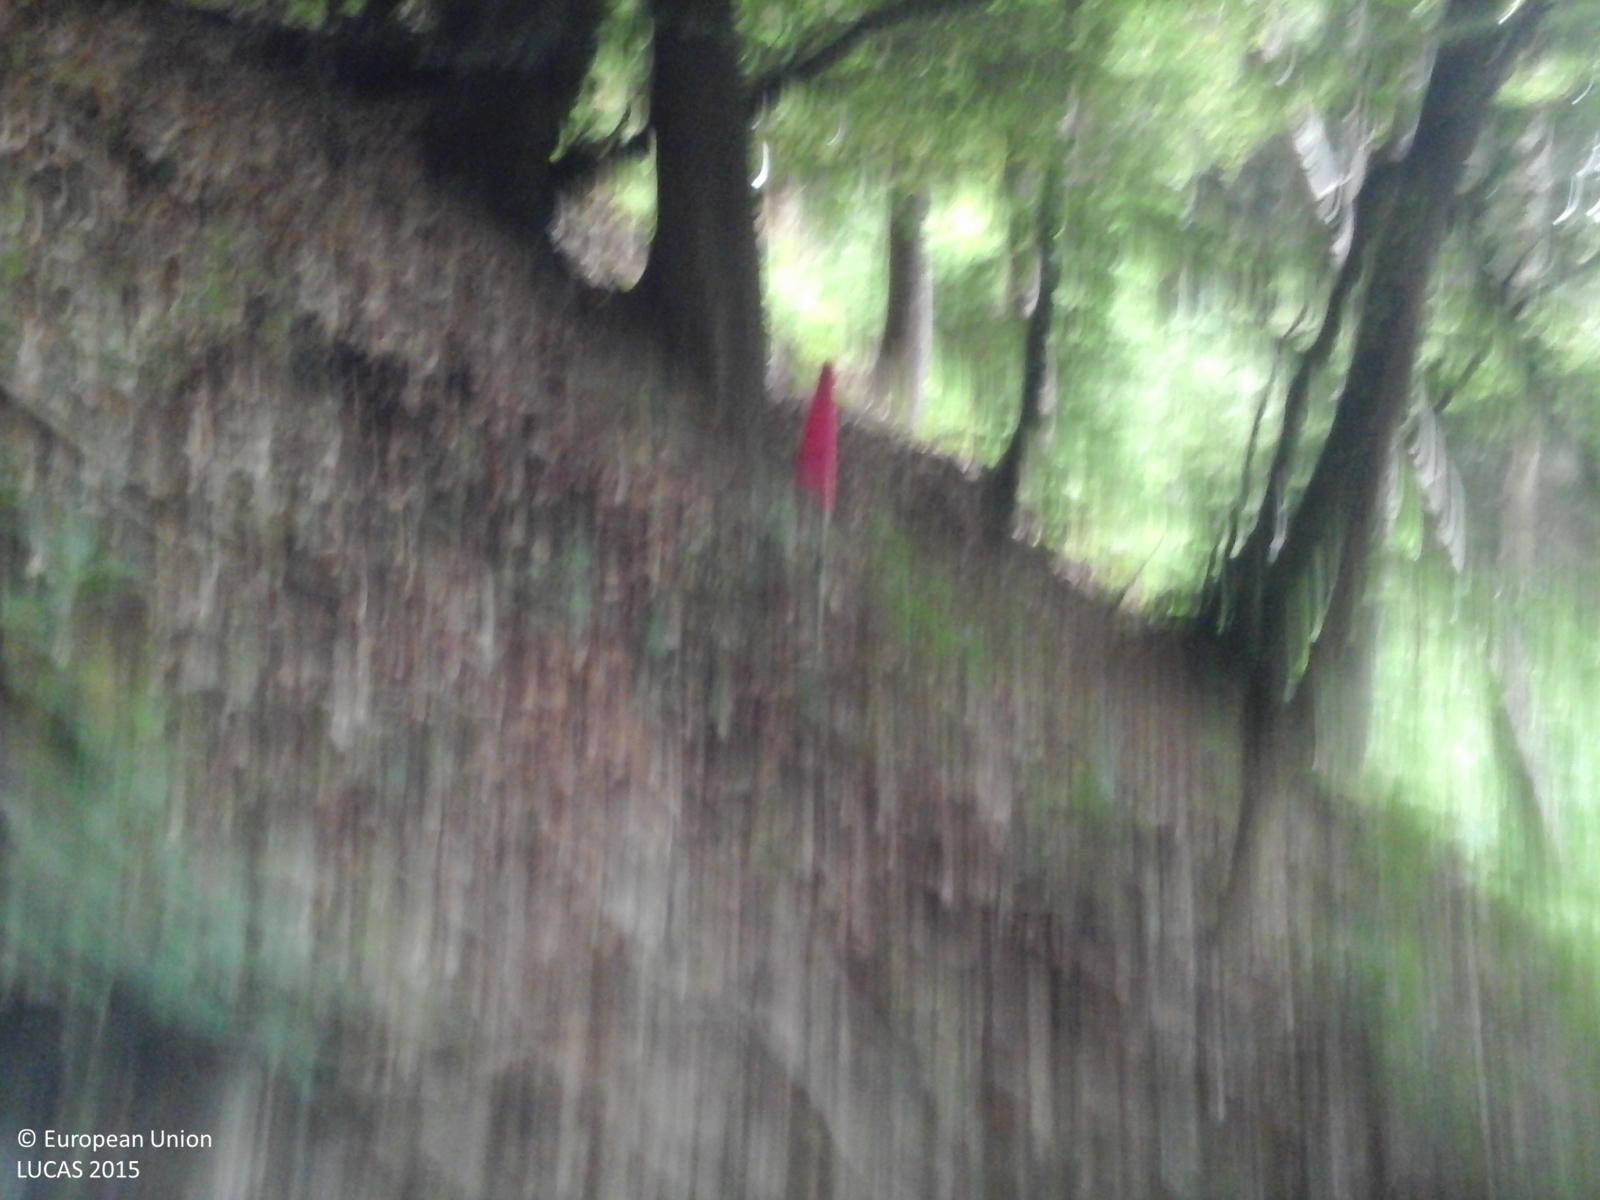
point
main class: Woodland
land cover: Other mixed woodland
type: alpine coniferous forest
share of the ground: > 75 %
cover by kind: coniferous forest trees 50 %, broadleaved forest trees 50 %
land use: Forestry
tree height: > 5 m
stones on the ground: < 10 %
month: May
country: IT
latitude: 45.8784
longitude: 10.9649
